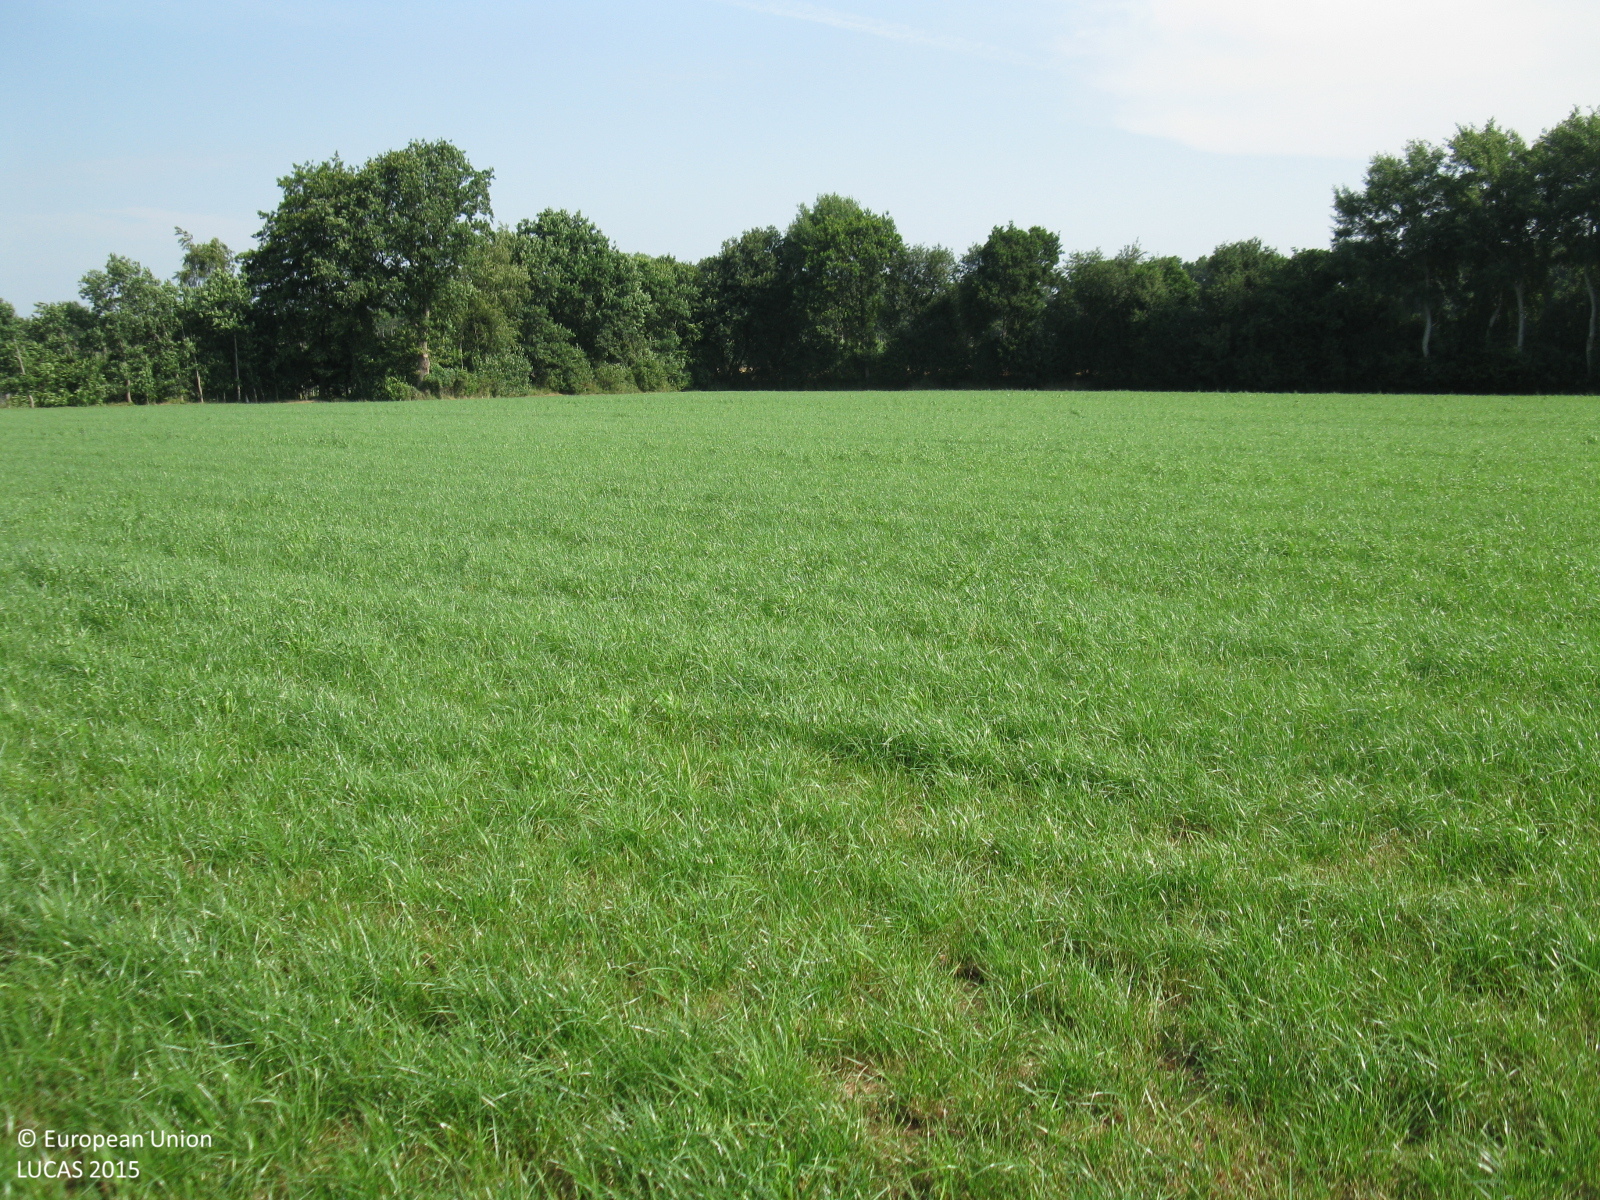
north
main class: Grassland
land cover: Grassland without tree/shrub cover
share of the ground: > 75 %
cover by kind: herbaceous plants 100 %
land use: Agriculture (excluding fallow land and kitchen gardens)
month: July
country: DE
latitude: 53.1858
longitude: 7.8906
